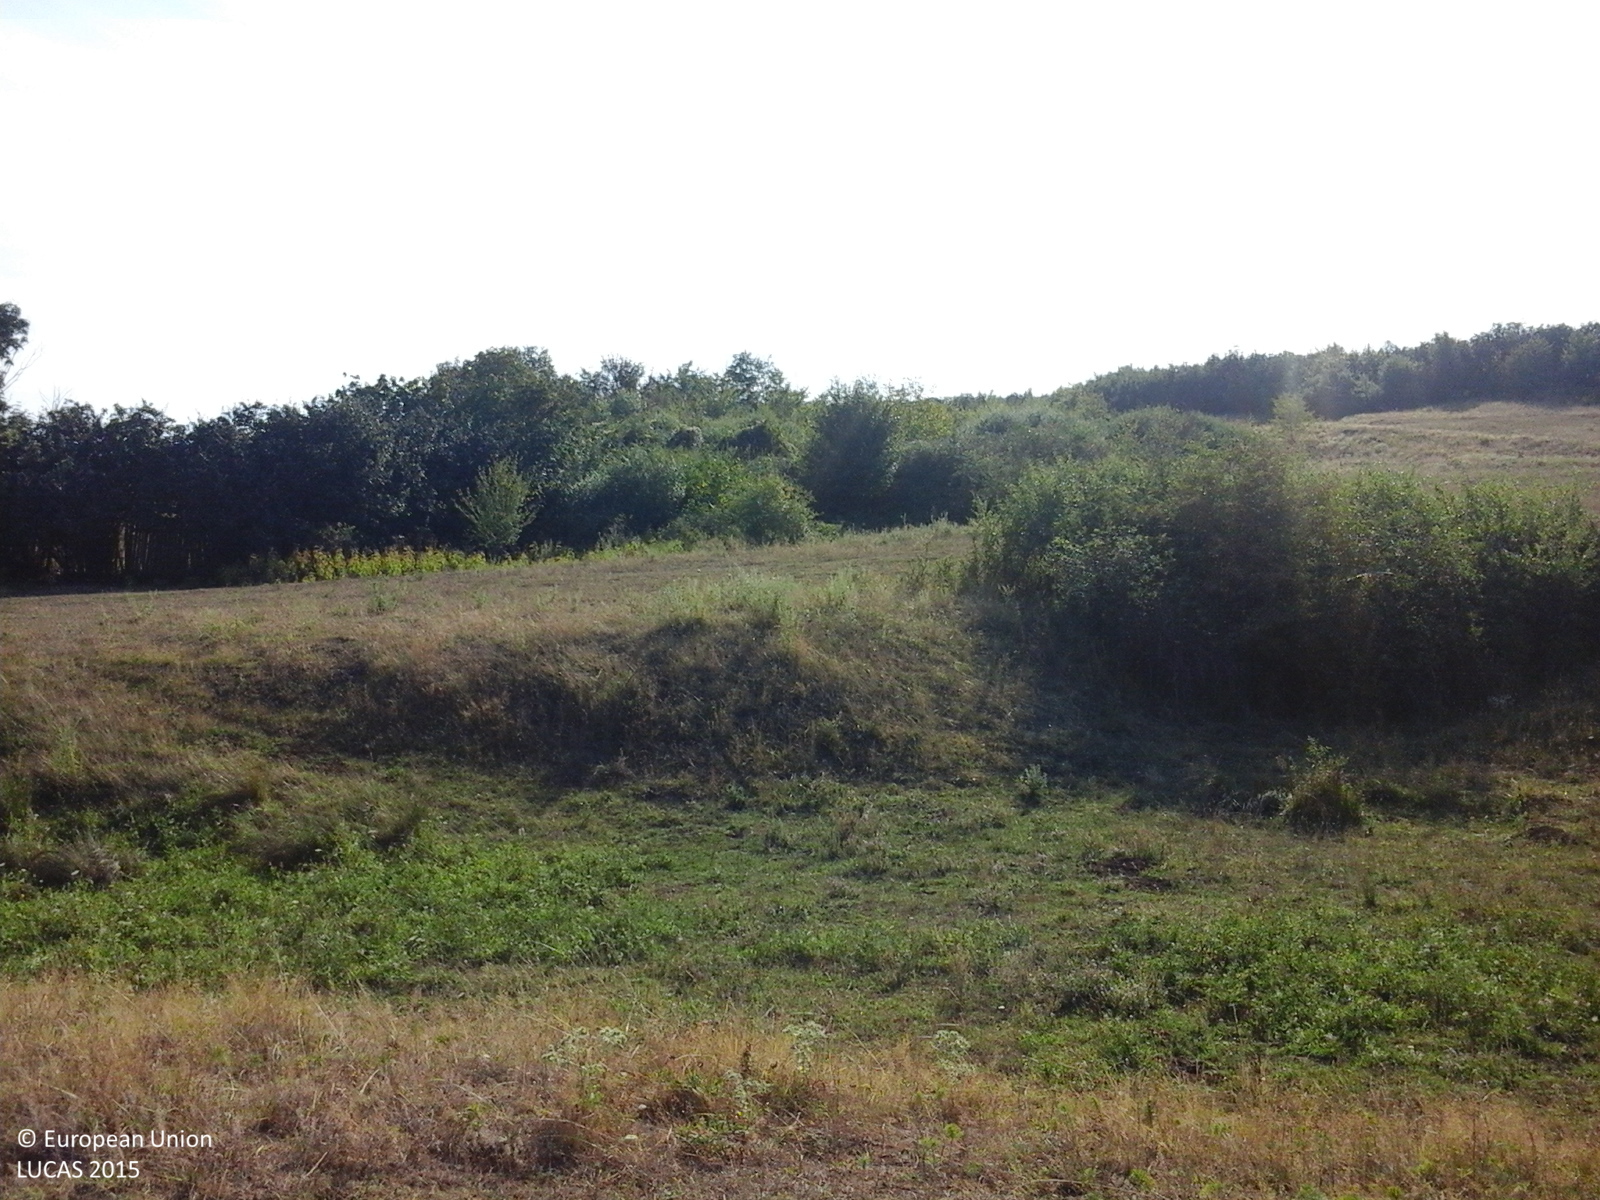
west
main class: Grassland
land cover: Spontaneously vegetated surfaces
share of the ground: > 75 %
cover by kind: herbaceous plants 100 %
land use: Semi-natural and natural areas not in use
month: August
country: RO
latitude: 45.1189
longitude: 21.5863
